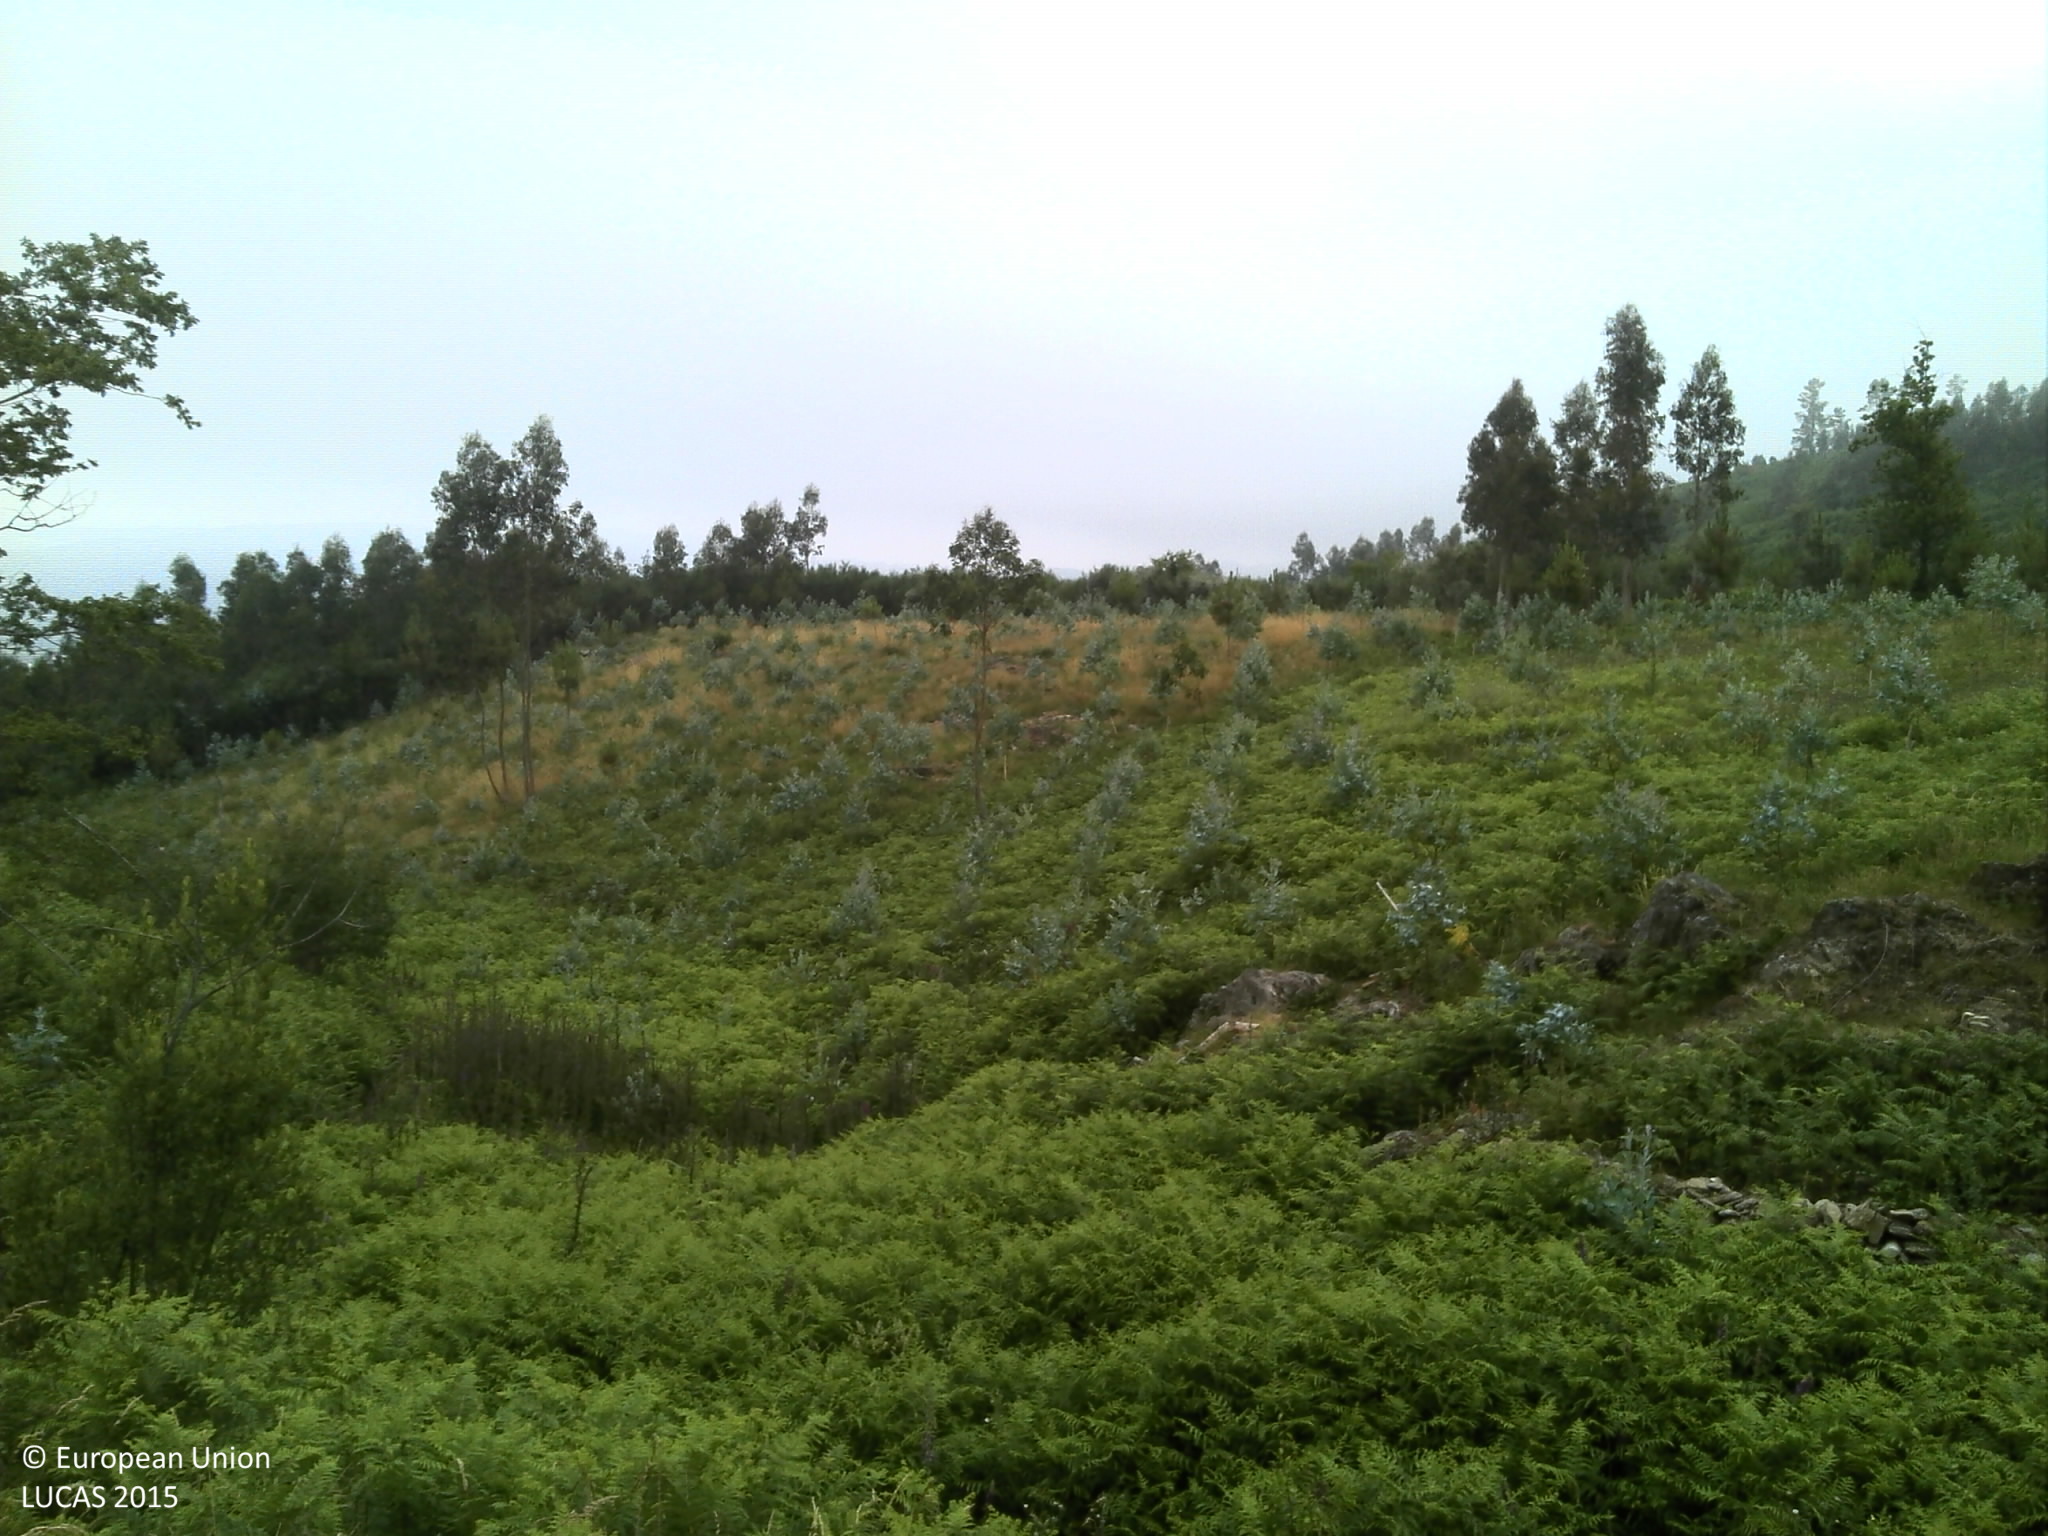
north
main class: Shrubland
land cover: Shrubland without tree cover
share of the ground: > 75 %
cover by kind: shrubs 85 %, unconsolidated bare surface 10 %, herbaceous plants 5 %
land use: Abandoned areas
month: June
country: PT
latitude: 40.8107
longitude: -8.3600
